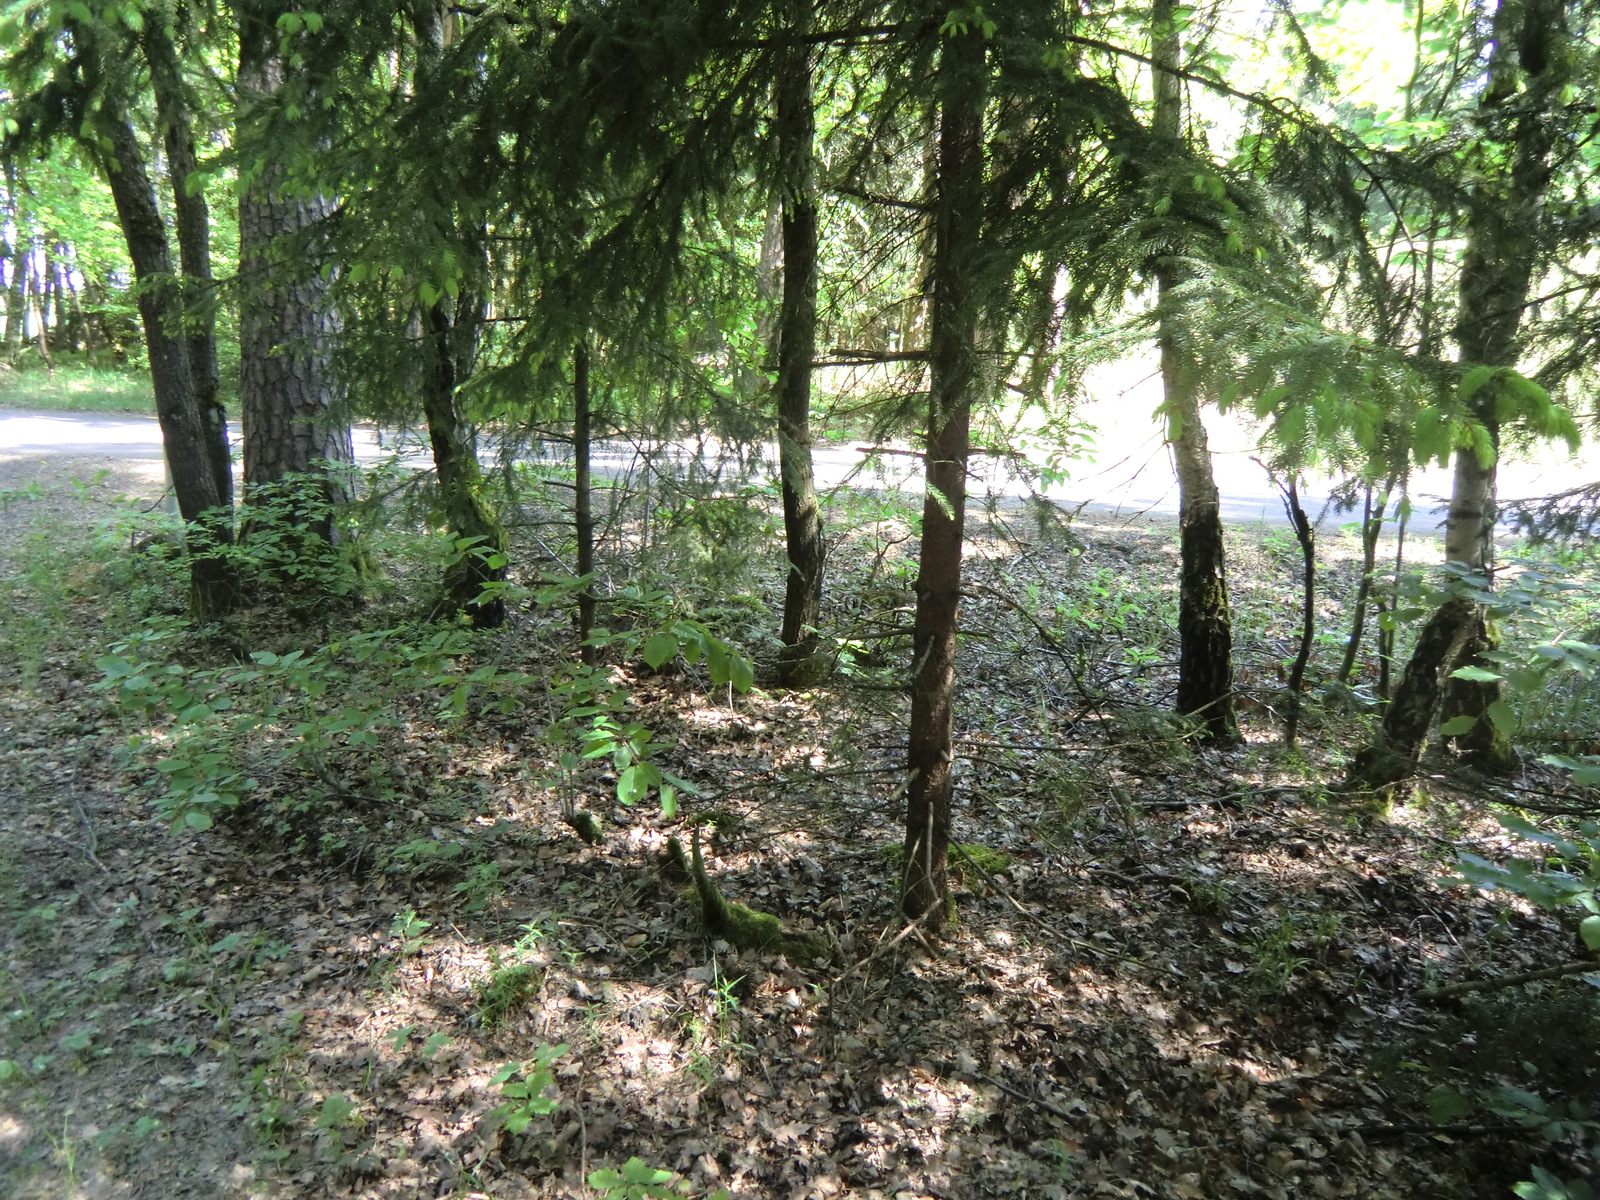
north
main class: Woodland
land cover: Pine dominated mixed woodland
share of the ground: > 75 %
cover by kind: coniferous forest trees 40 %, broadleaved forest trees 40 %, shrubs 5 %, herbaceous plants 5 %, lichens and mosses 5 %, consolidated bare surface 5 %
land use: Forestry
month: May
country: AT
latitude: 48.3145
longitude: 14.4368
